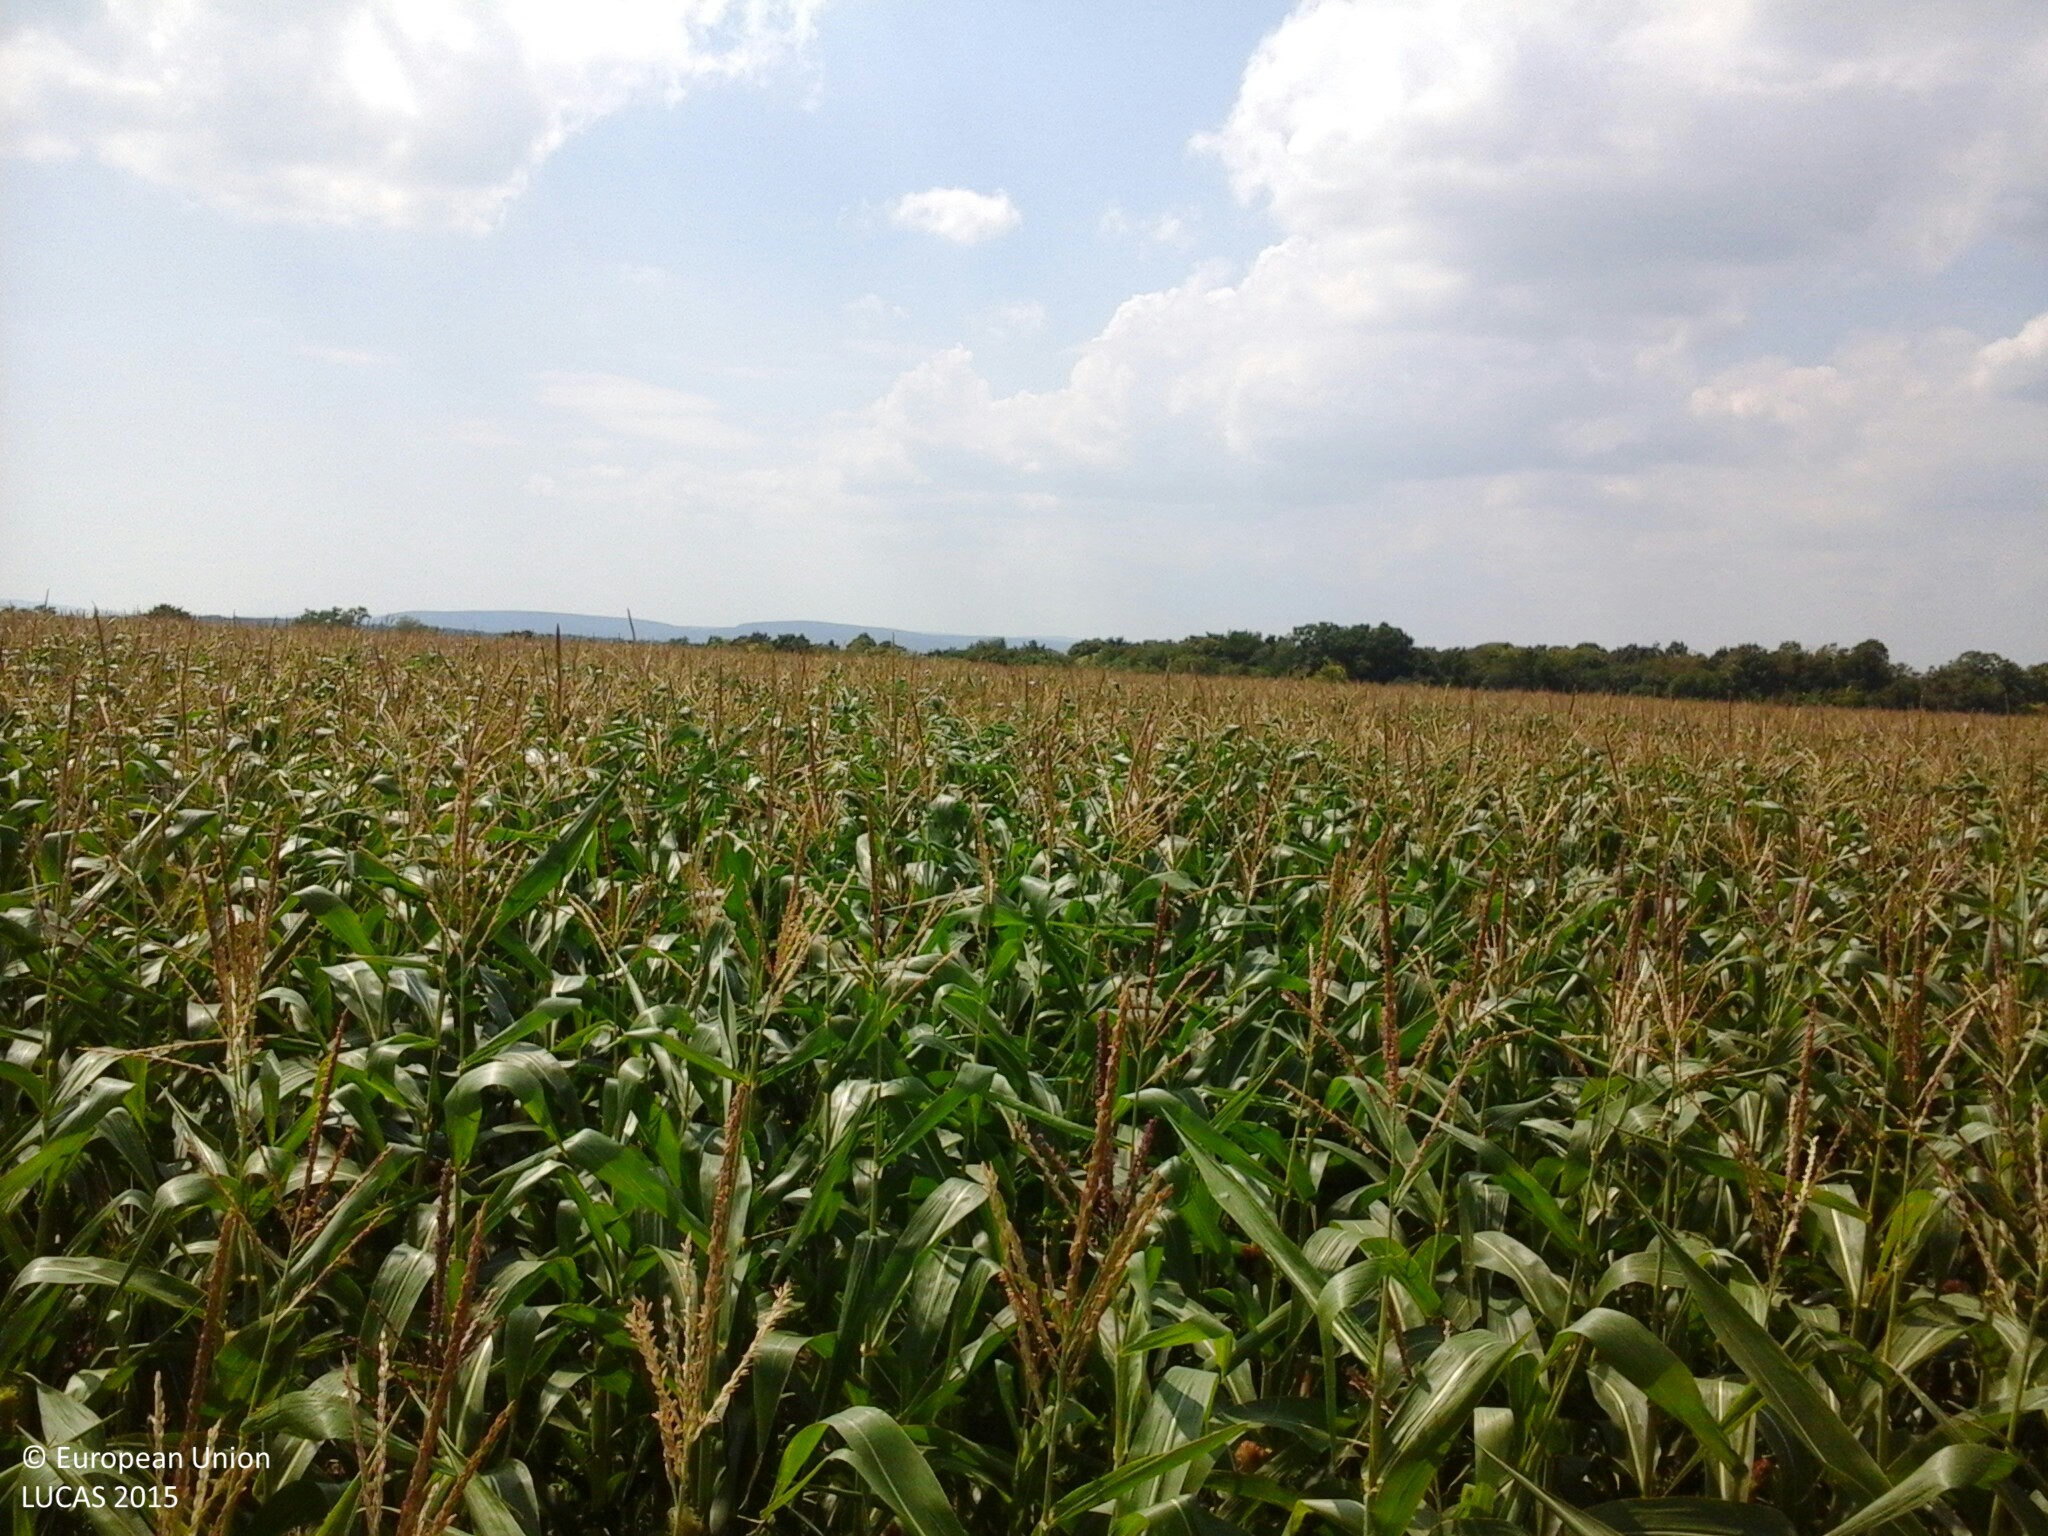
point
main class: Cropland
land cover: Maize
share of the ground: > 75 %
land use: Agriculture (excluding fallow land and kitchen gardens)
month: August
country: HU
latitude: 47.0545
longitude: 18.1326
